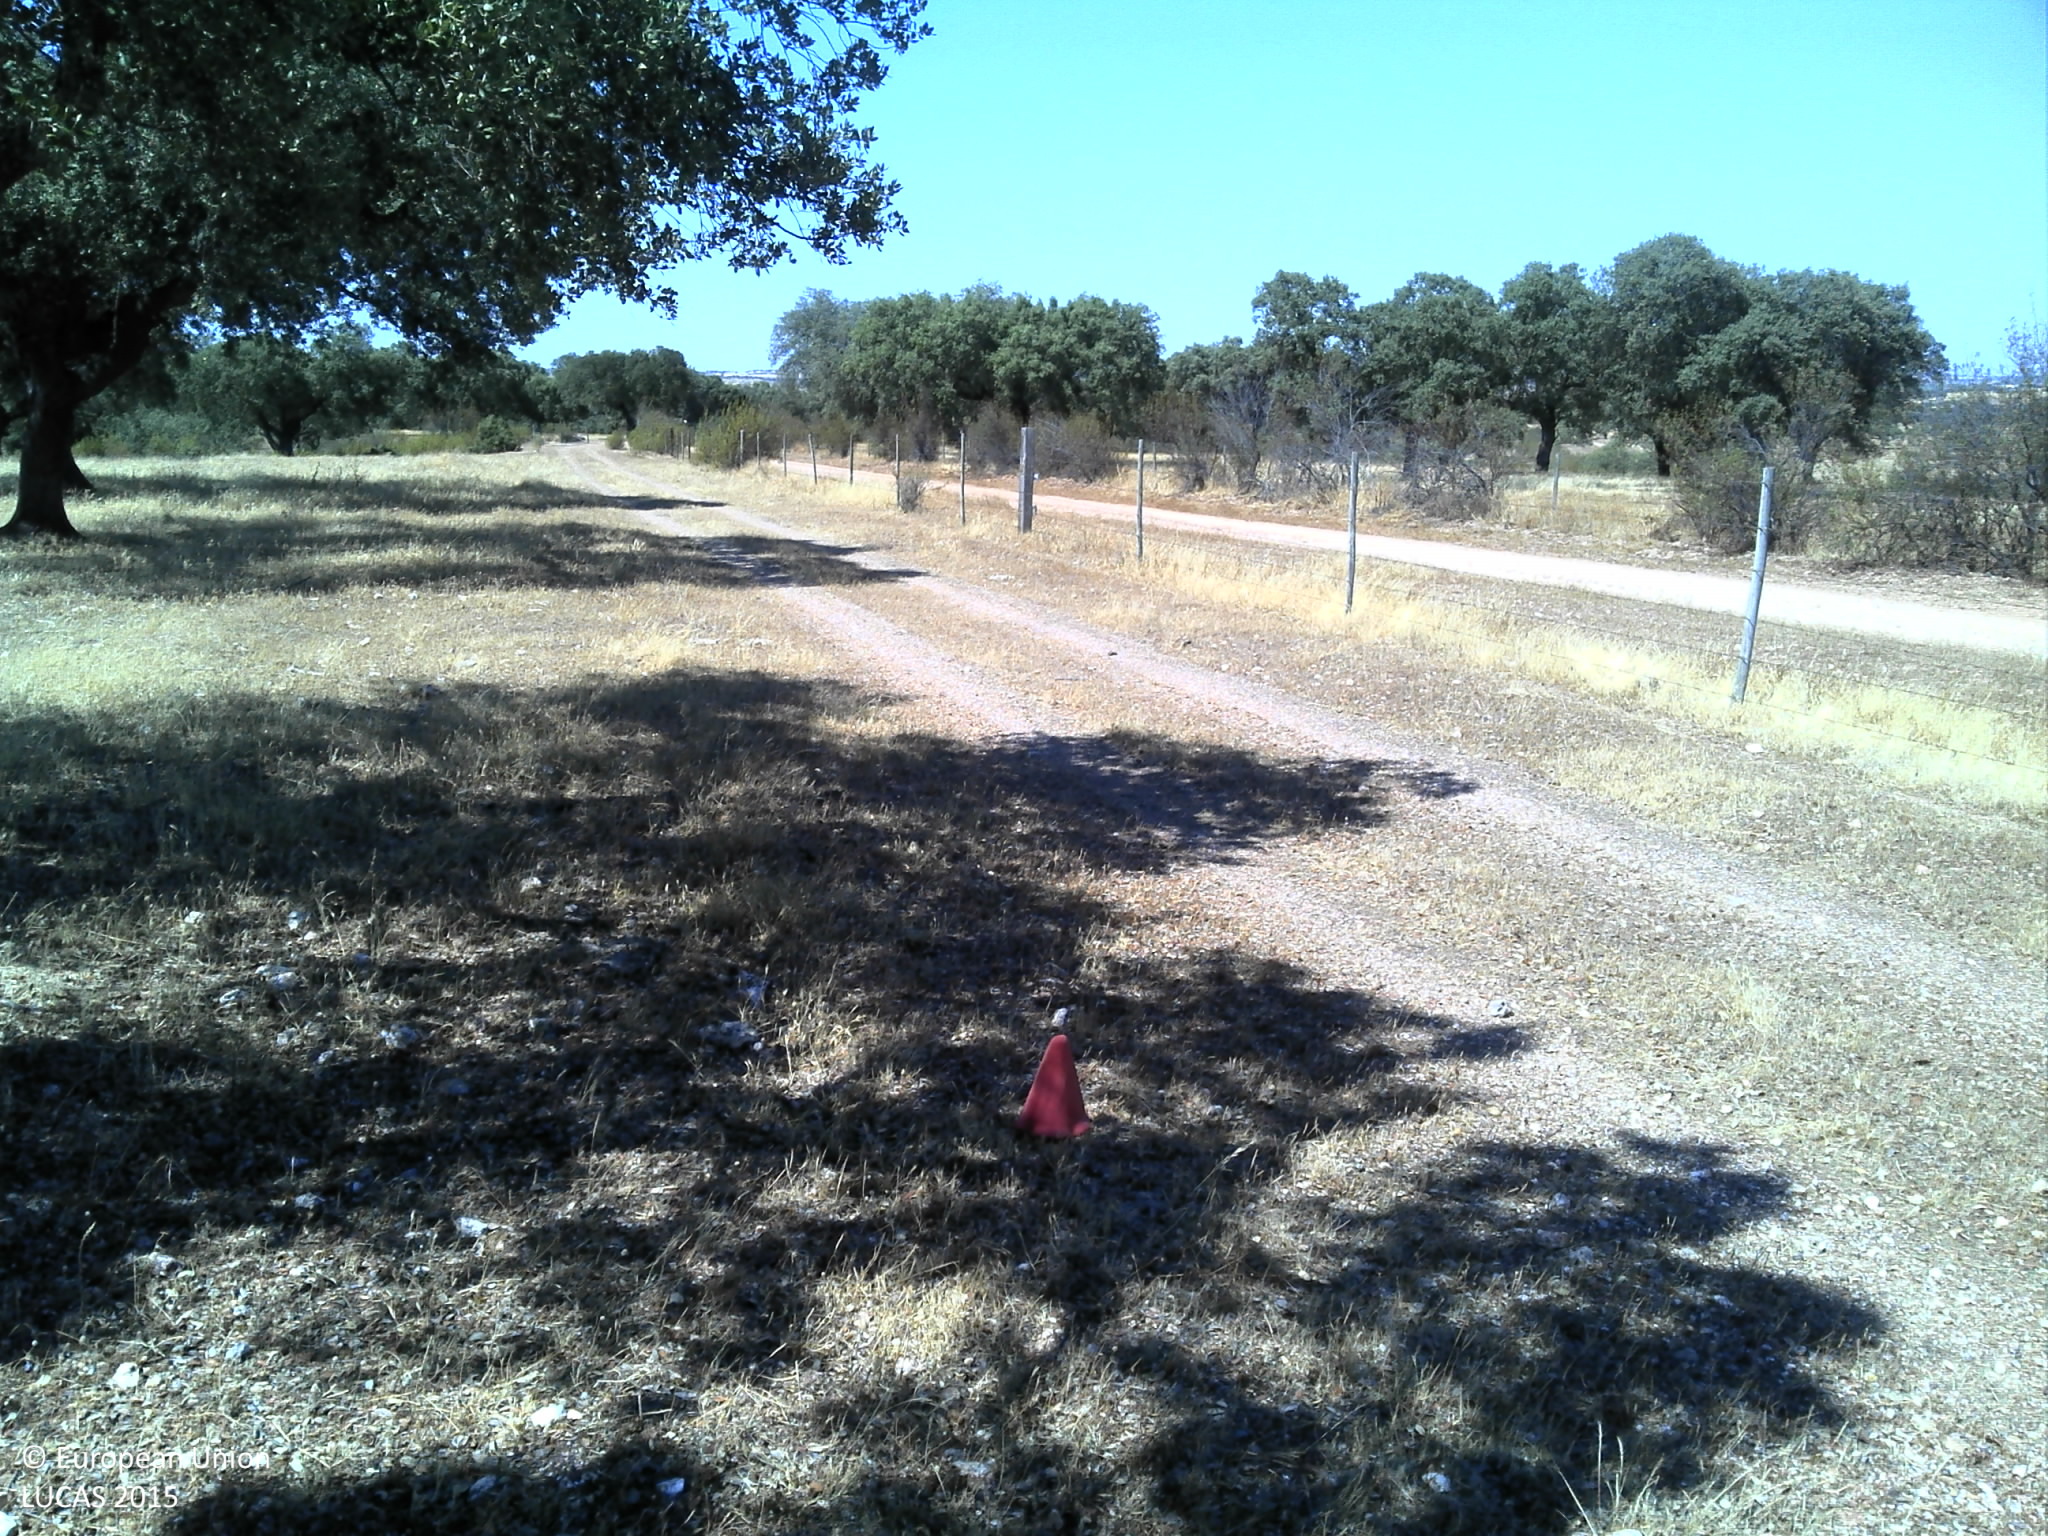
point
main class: Woodland
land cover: Broadleaved woodland
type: broadleaved evergreen forest
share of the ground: 25 - 50 %
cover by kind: broadleaved forest trees 45 %, unconsolidated bare surface 35 %, herbaceous plants 20 %
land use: Forestry
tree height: > 5 m
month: July
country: PT
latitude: 38.1576
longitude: -7.3311
